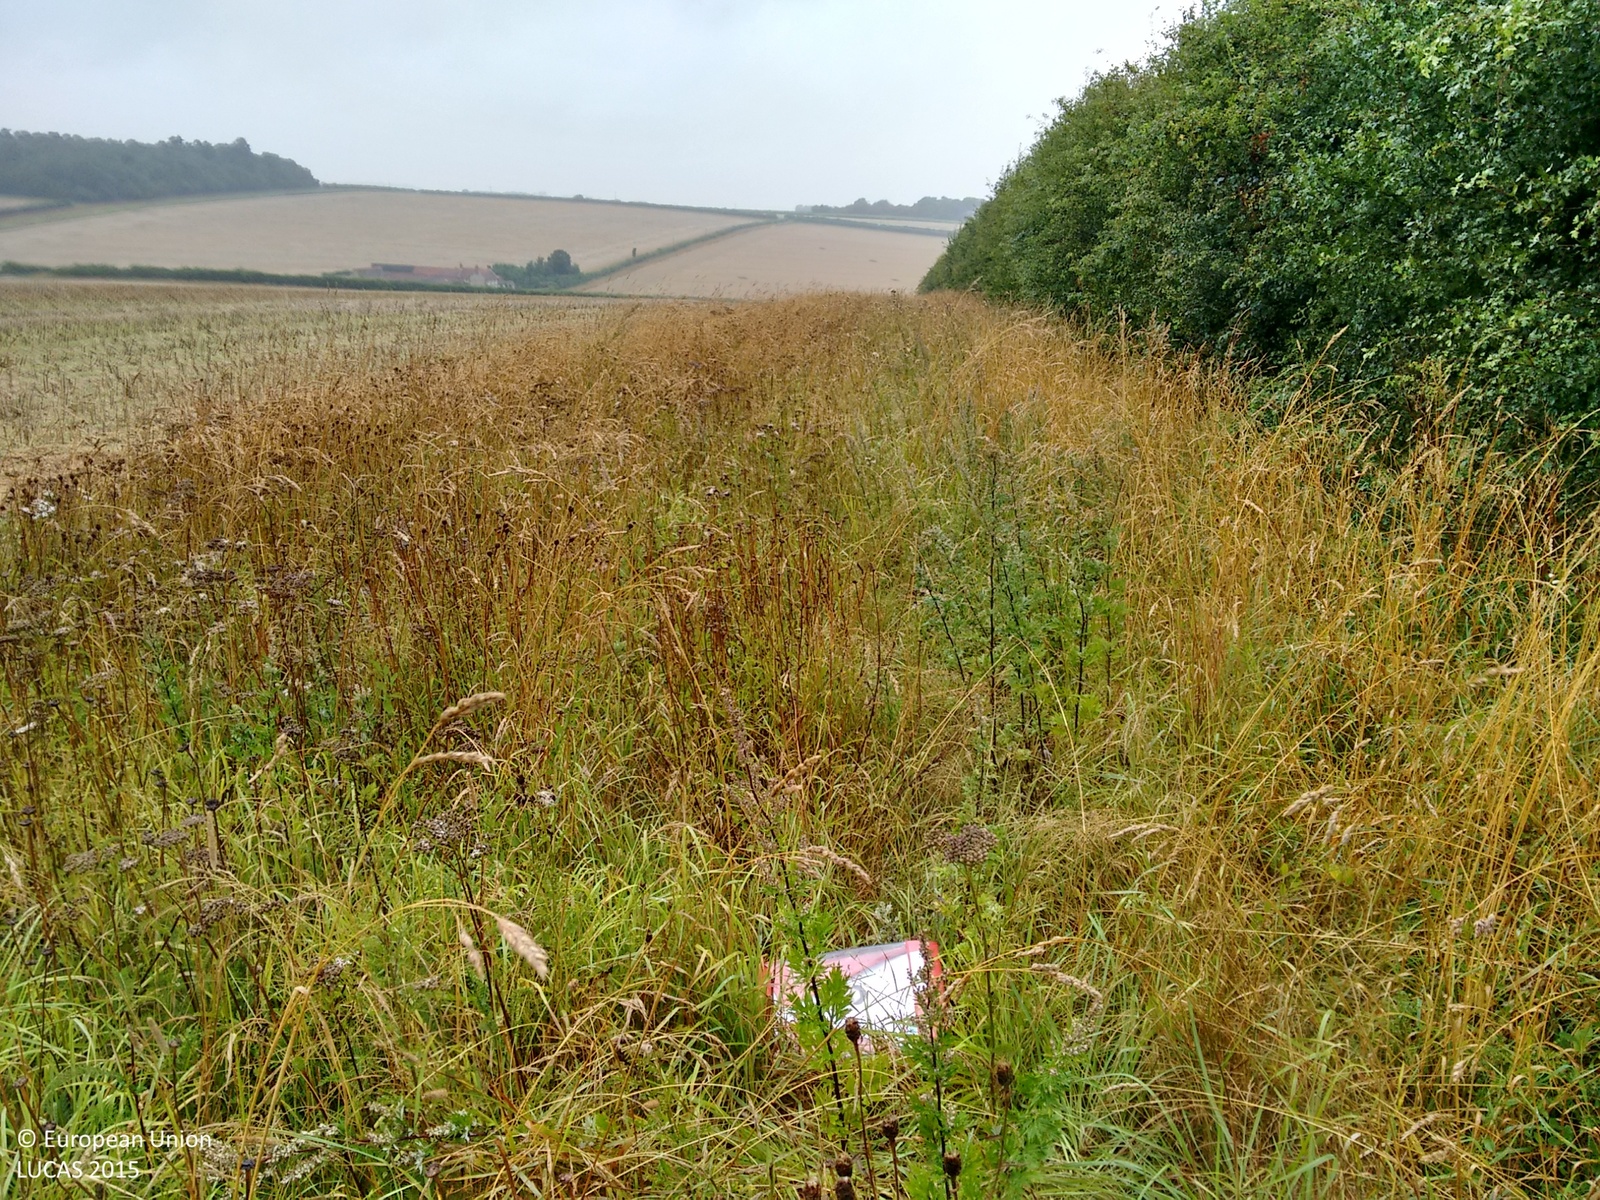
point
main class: Grassland
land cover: Spontaneously vegetated surfaces
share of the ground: > 75 %
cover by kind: herbaceous plants 100 %
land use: Agriculture (excluding fallow land and kitchen gardens)
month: August
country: GB
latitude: 52.9019
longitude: 0.7426
